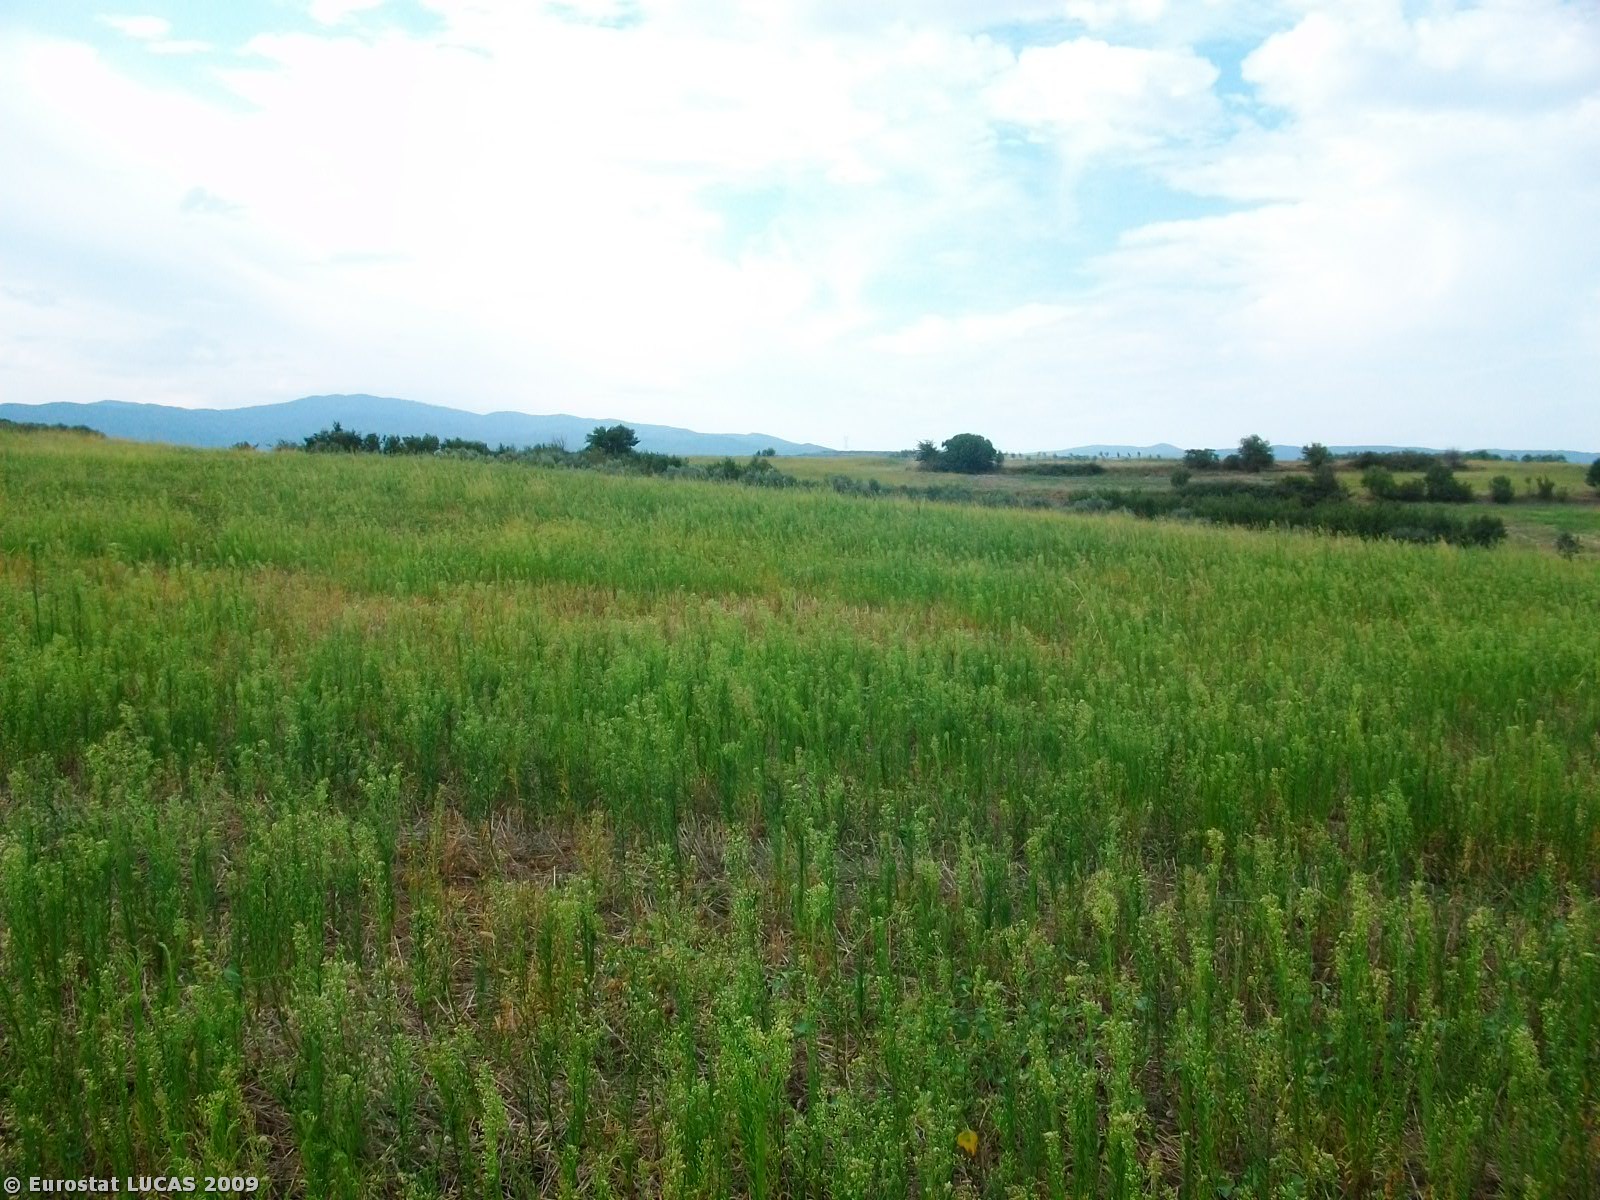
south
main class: Cropland
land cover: Durum wheat
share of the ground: 50 - 75 %
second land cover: Spontaneously vegetated surfaces
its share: 50 - 75 %
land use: Agriculture (excluding fallow land and kitchen gardens)
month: September
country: GR
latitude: 40.8892
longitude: 23.6081
